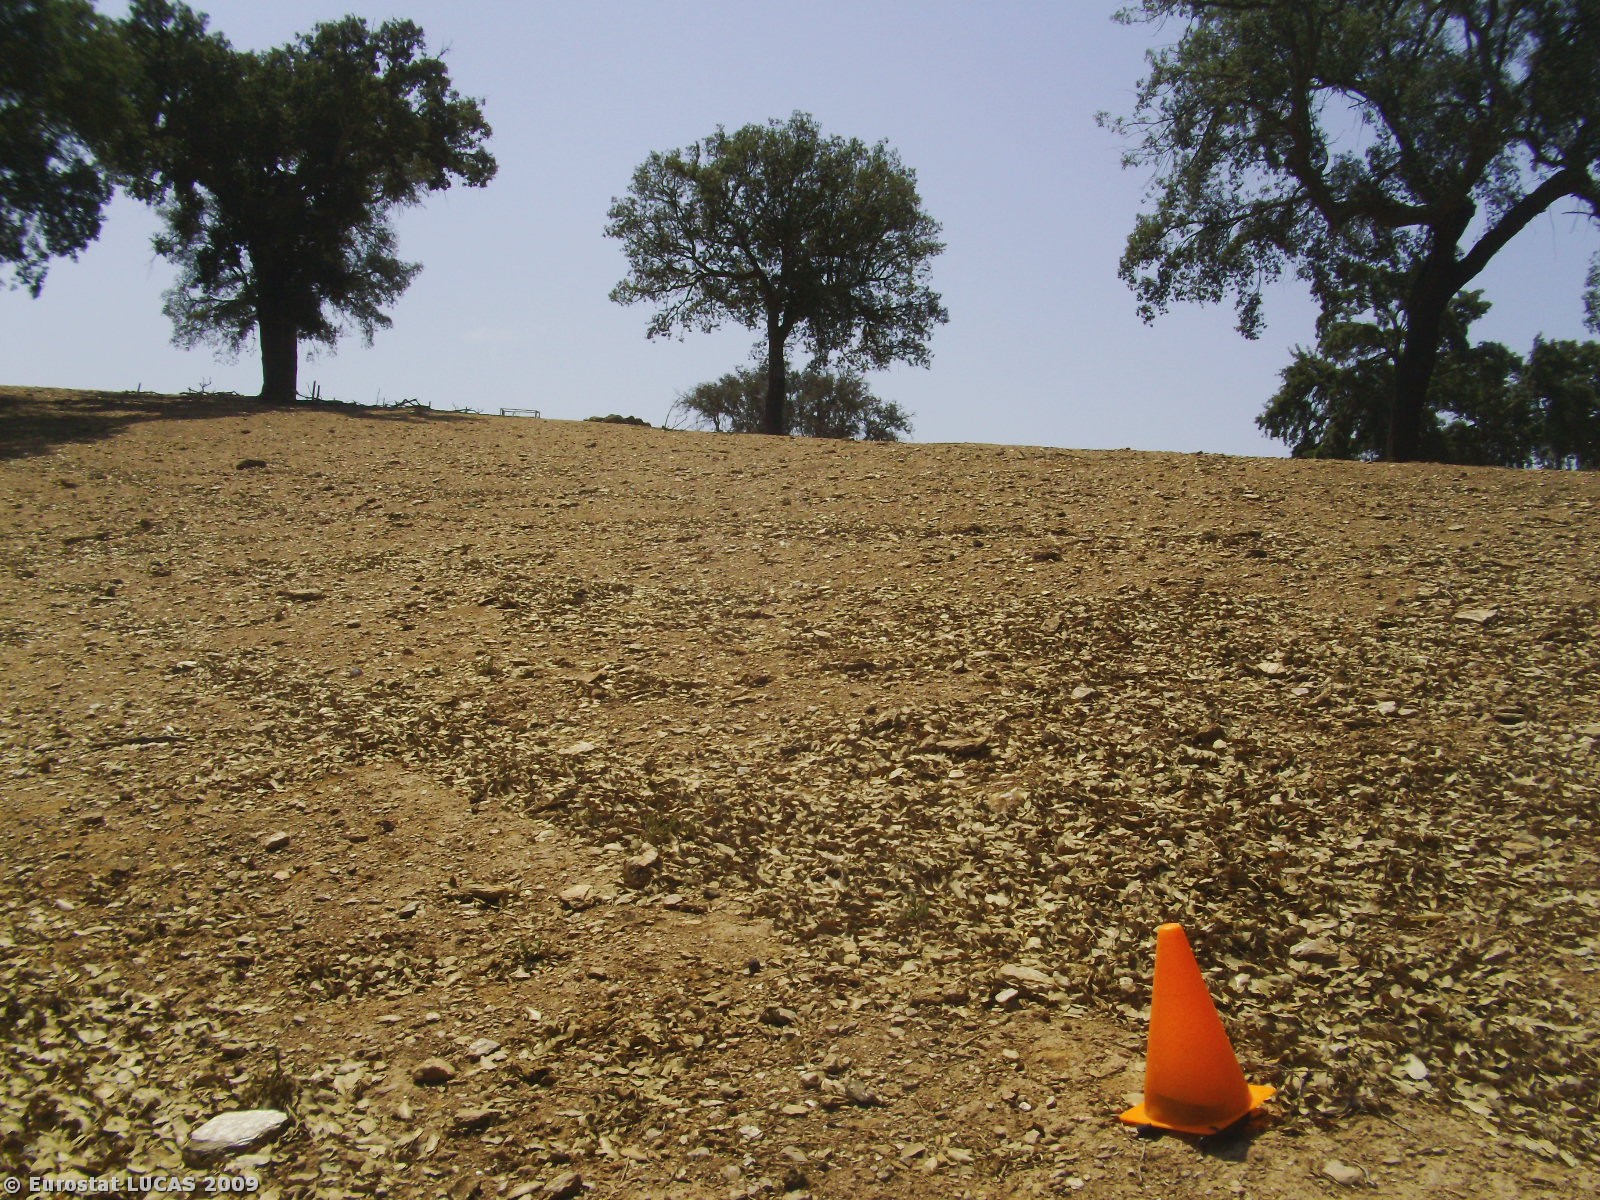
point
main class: Woodland
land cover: Broadleaved woodland
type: broadleaved evergreen forest
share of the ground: 10 - 25 %
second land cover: Bare land
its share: > 75 %
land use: Forestry
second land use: Agriculture (excluding fallow land and kitchen gardens)
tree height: > 5 m
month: August
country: PT
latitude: 38.3646
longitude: -7.8072
